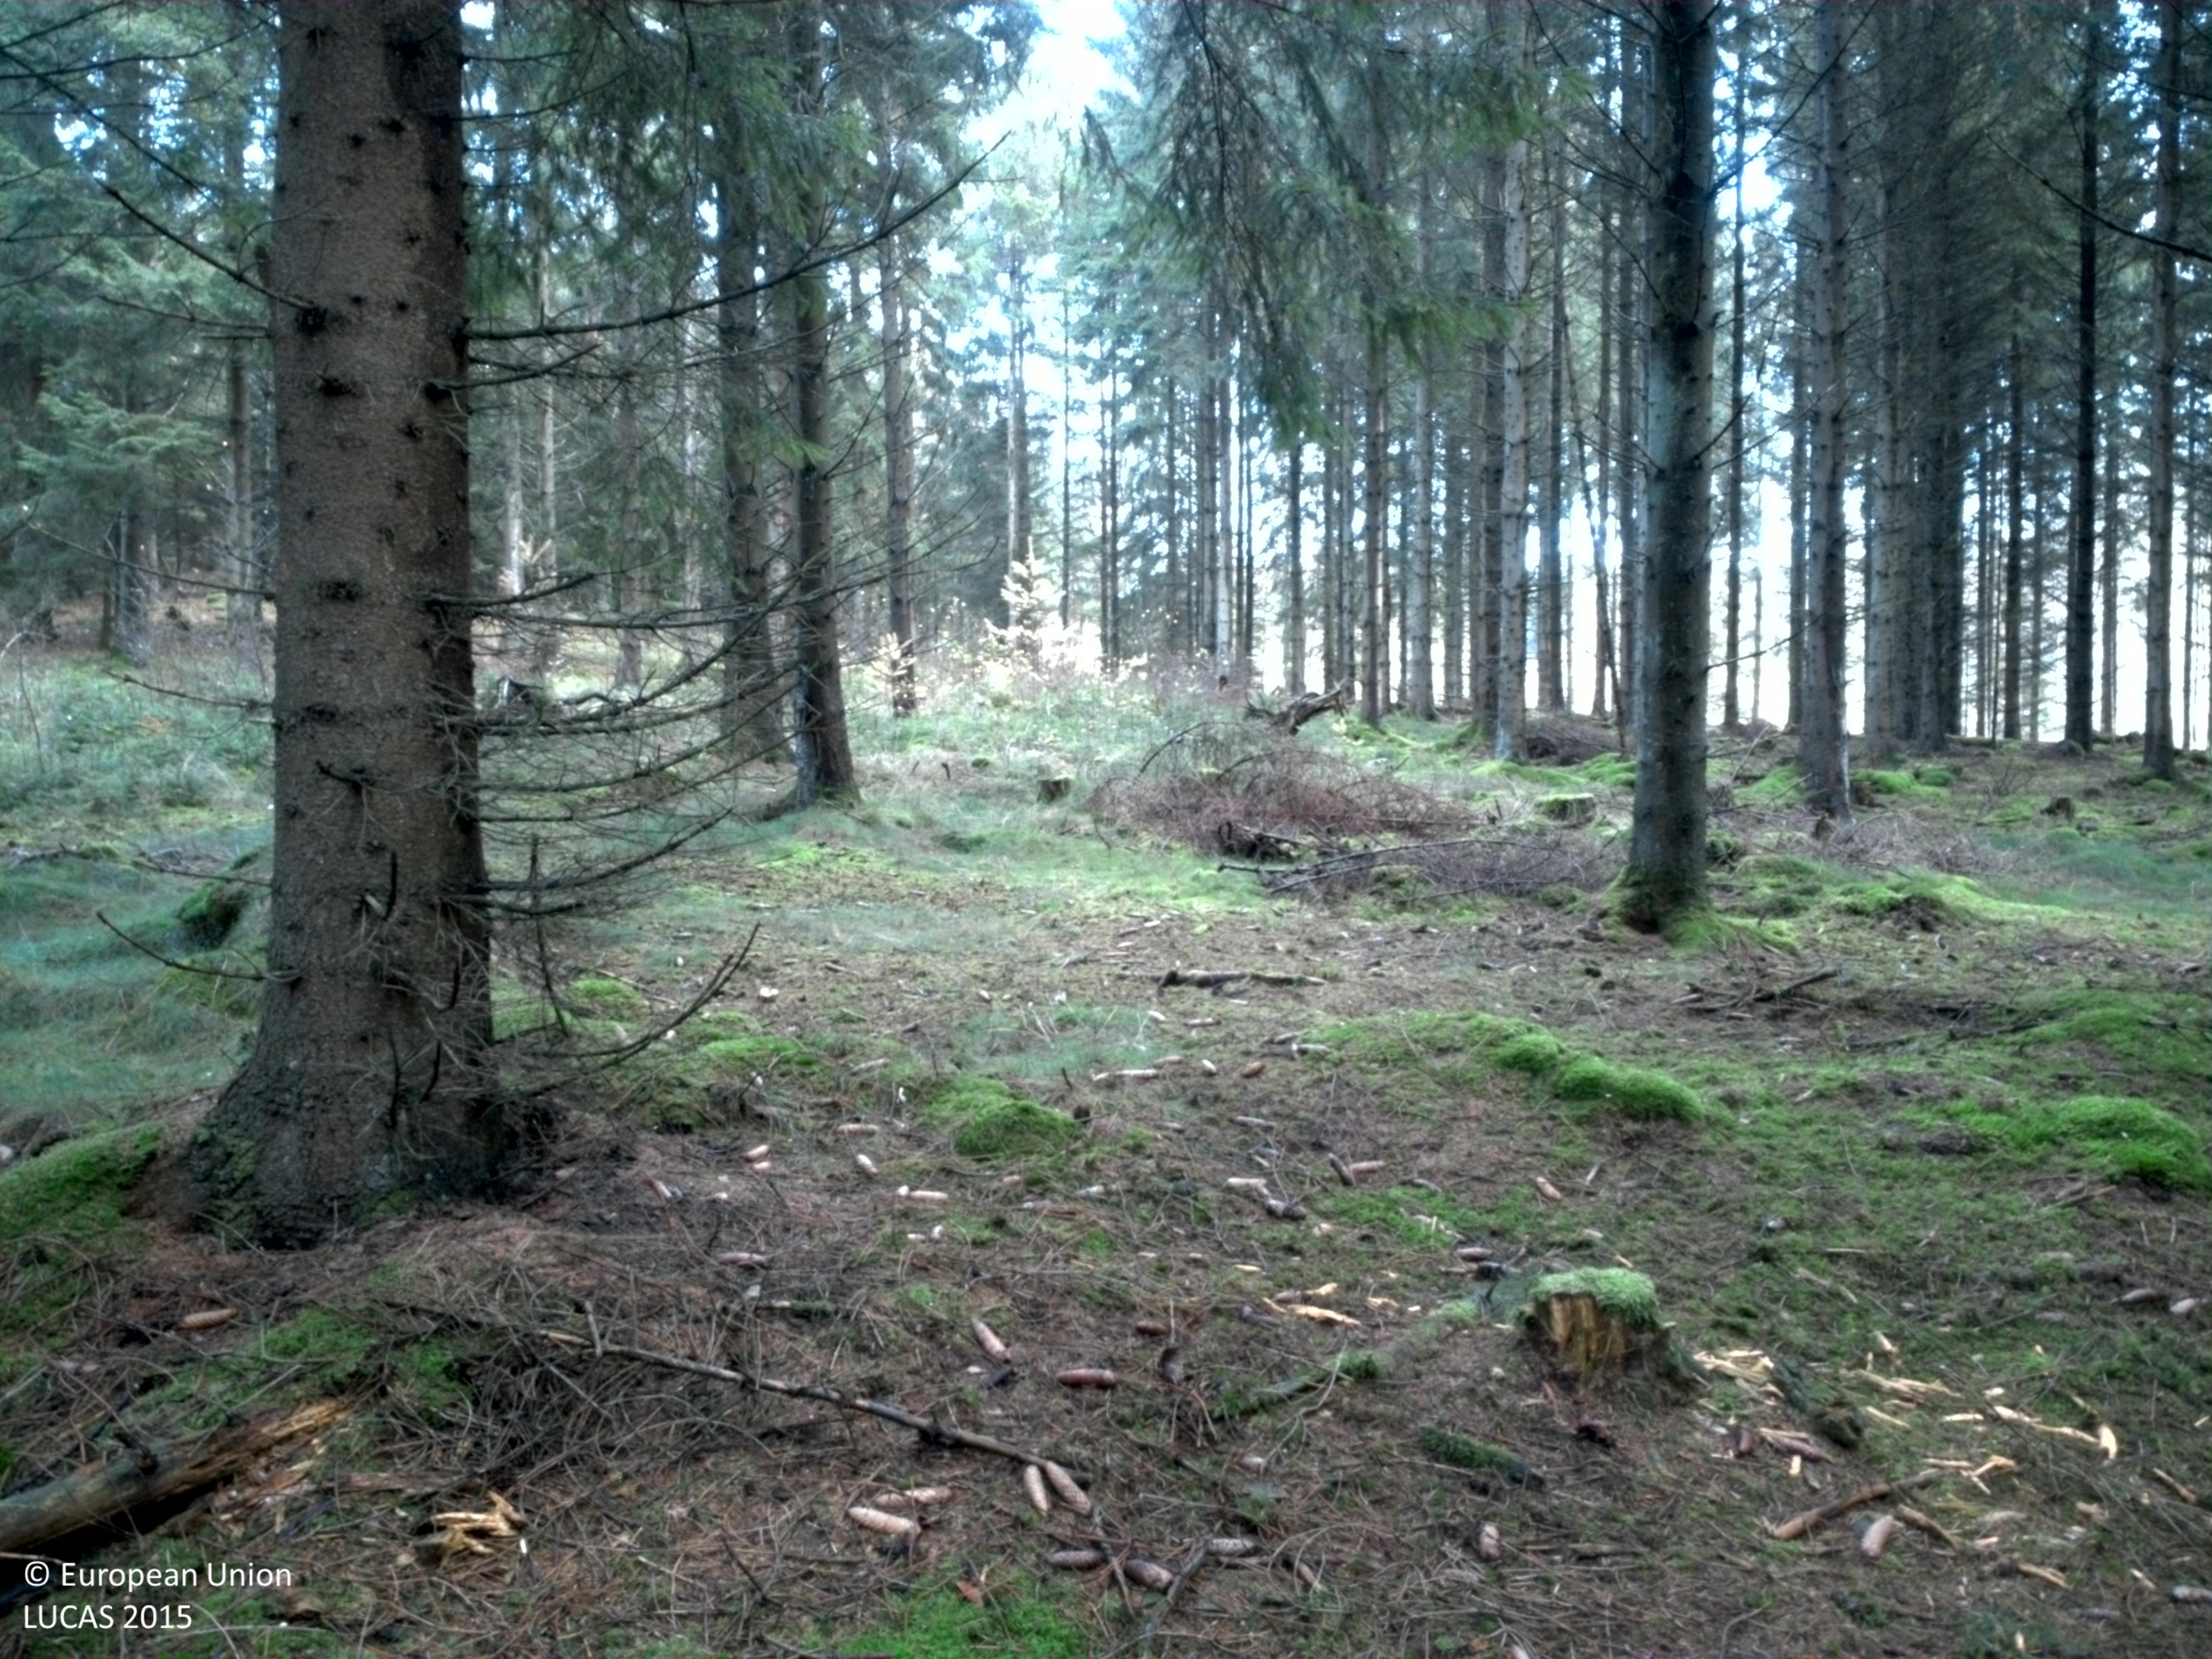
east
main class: Woodland
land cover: Spruce dominated coniferous woodland
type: hemiboreal forest and nemoral coniferous forest and mixed broadleaved-coniferous forest
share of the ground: > 75 %
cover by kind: coniferous forest trees 75 %, lichens and mosses 15 %, herbaceous plants 10 %
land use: Forestry
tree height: > 5 m
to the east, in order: Spruce dominated coniferous woodland; Spruce dominated mixed woodland
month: November
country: SE
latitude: 56.1487
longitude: 13.1685
